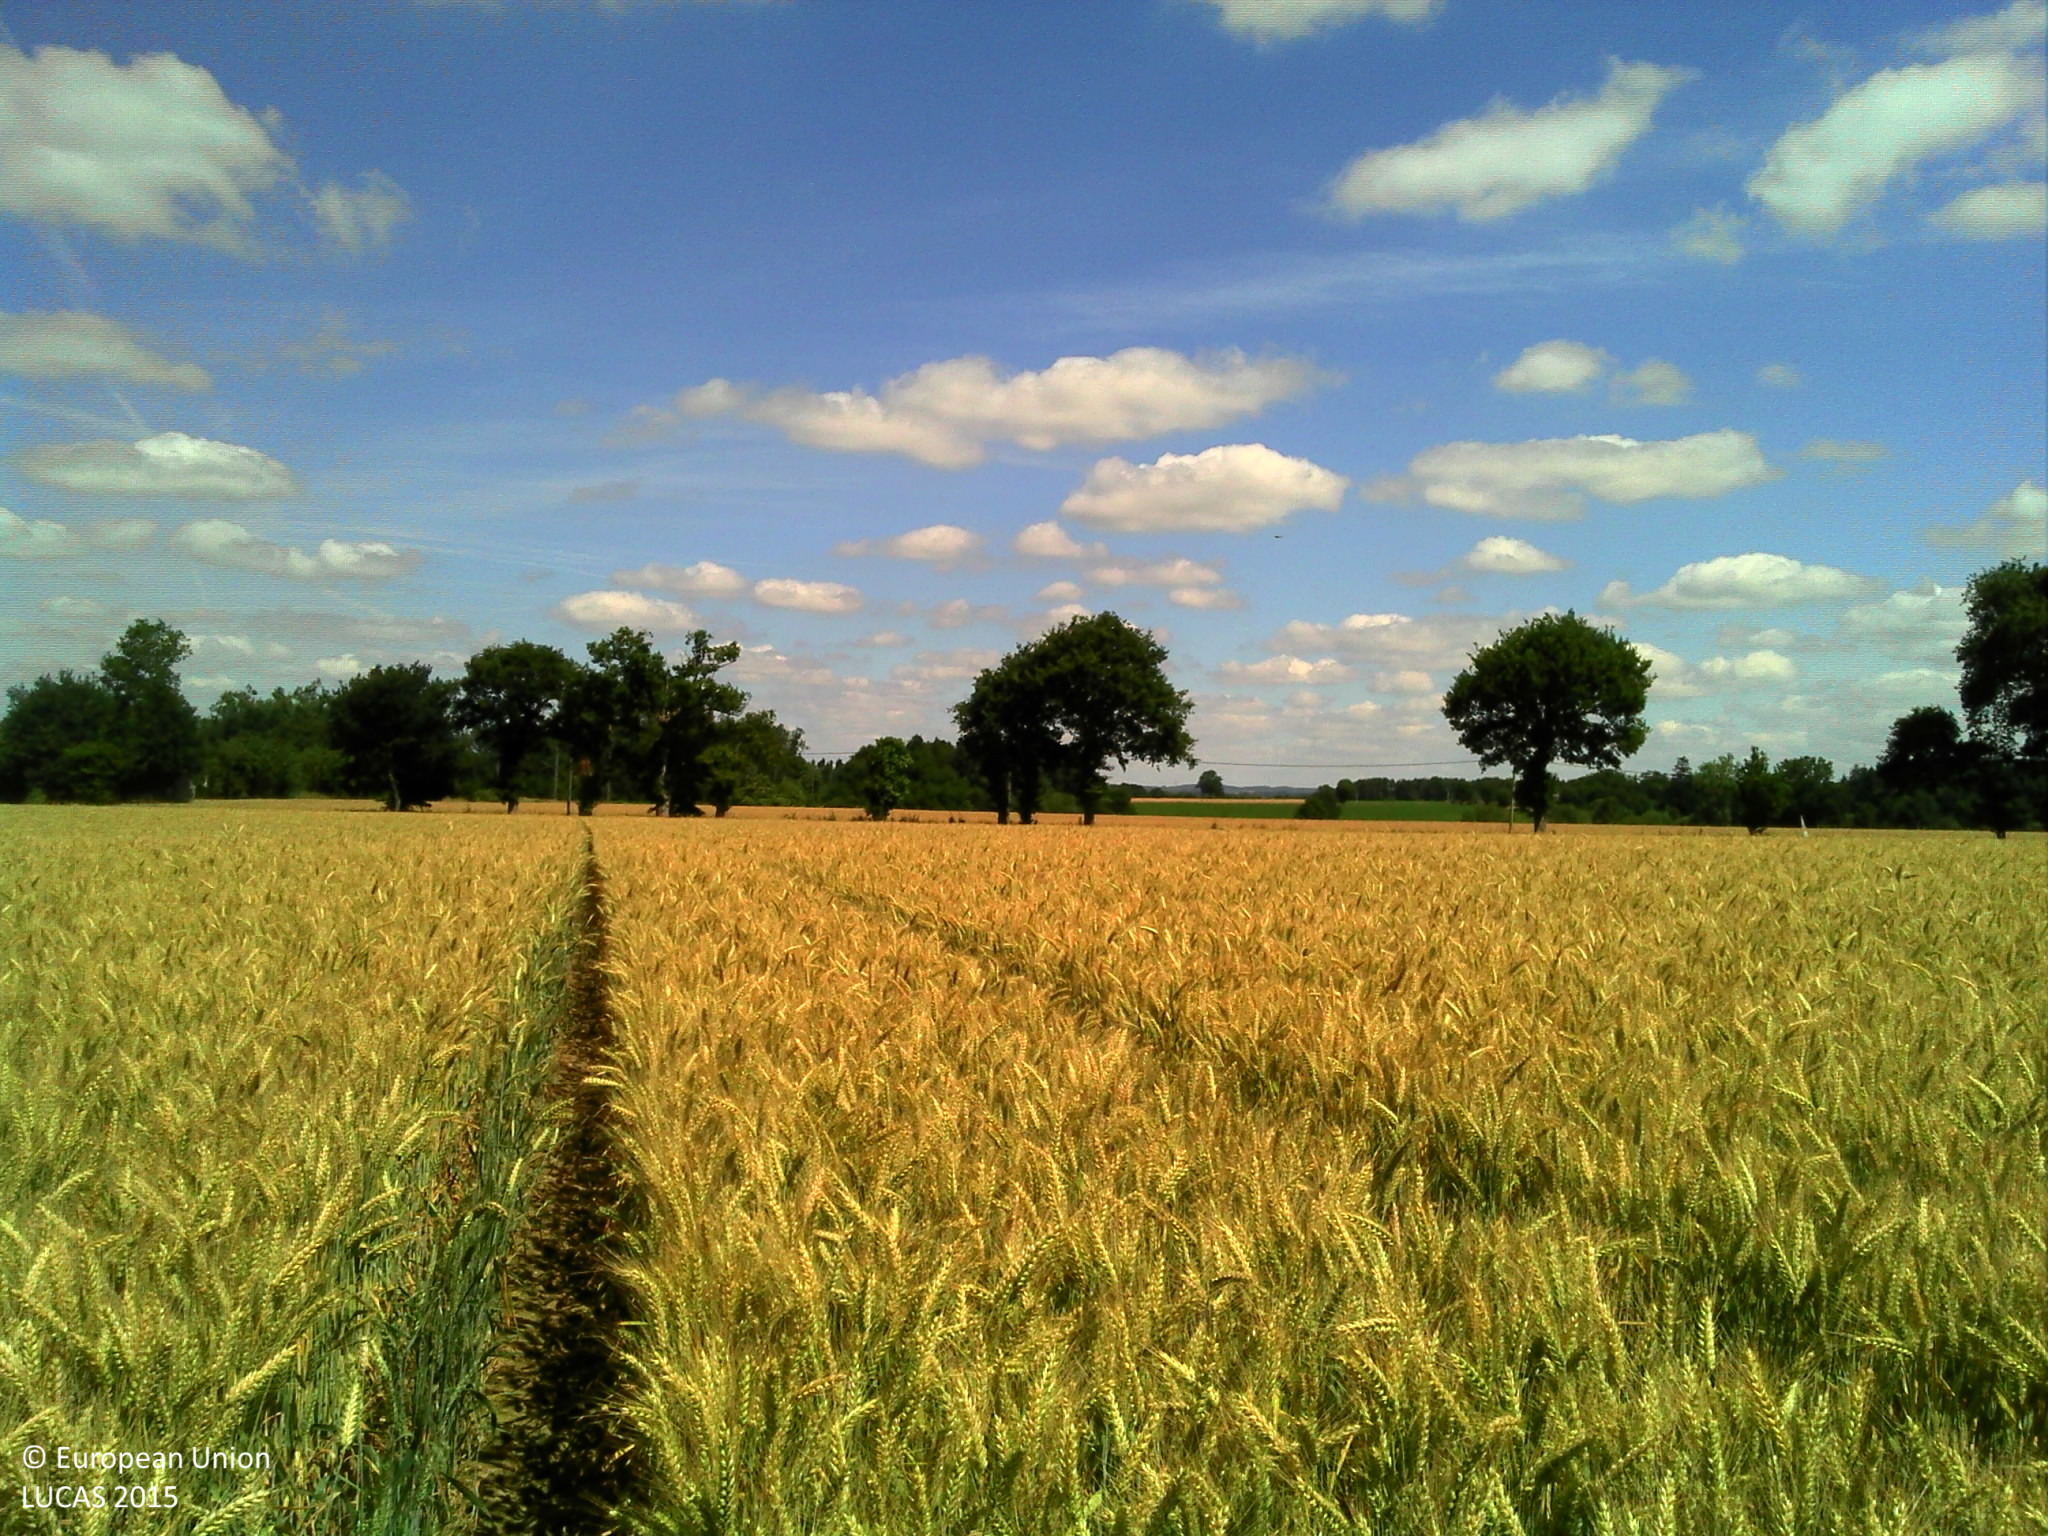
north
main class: Cropland
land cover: Common wheat
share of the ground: > 75 %
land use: Agriculture (excluding fallow land and kitchen gardens)
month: June
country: FR
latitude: 47.7836
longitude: -1.8341
